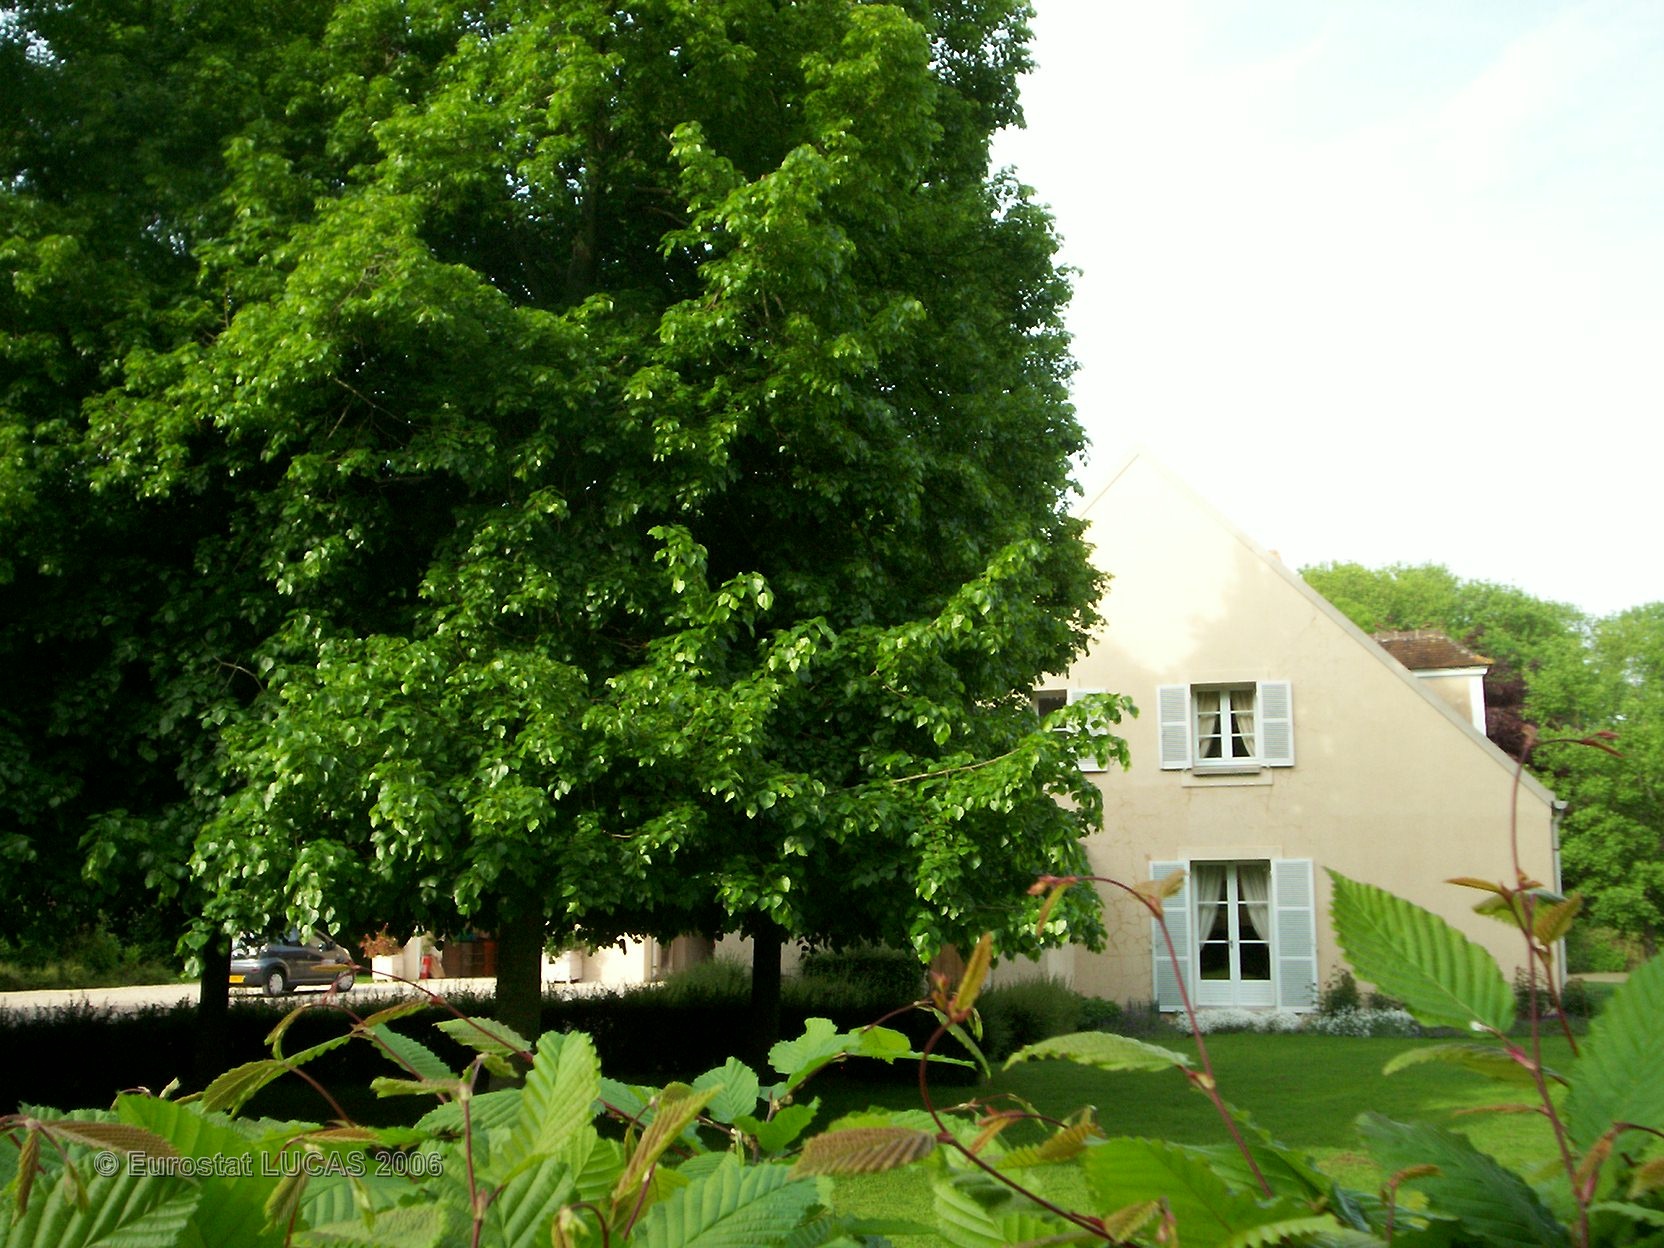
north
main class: Grassland
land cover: Grassland with sparse tree/shrub cover
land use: Residential
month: May
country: FR
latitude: 48.5854
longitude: 2.8195
